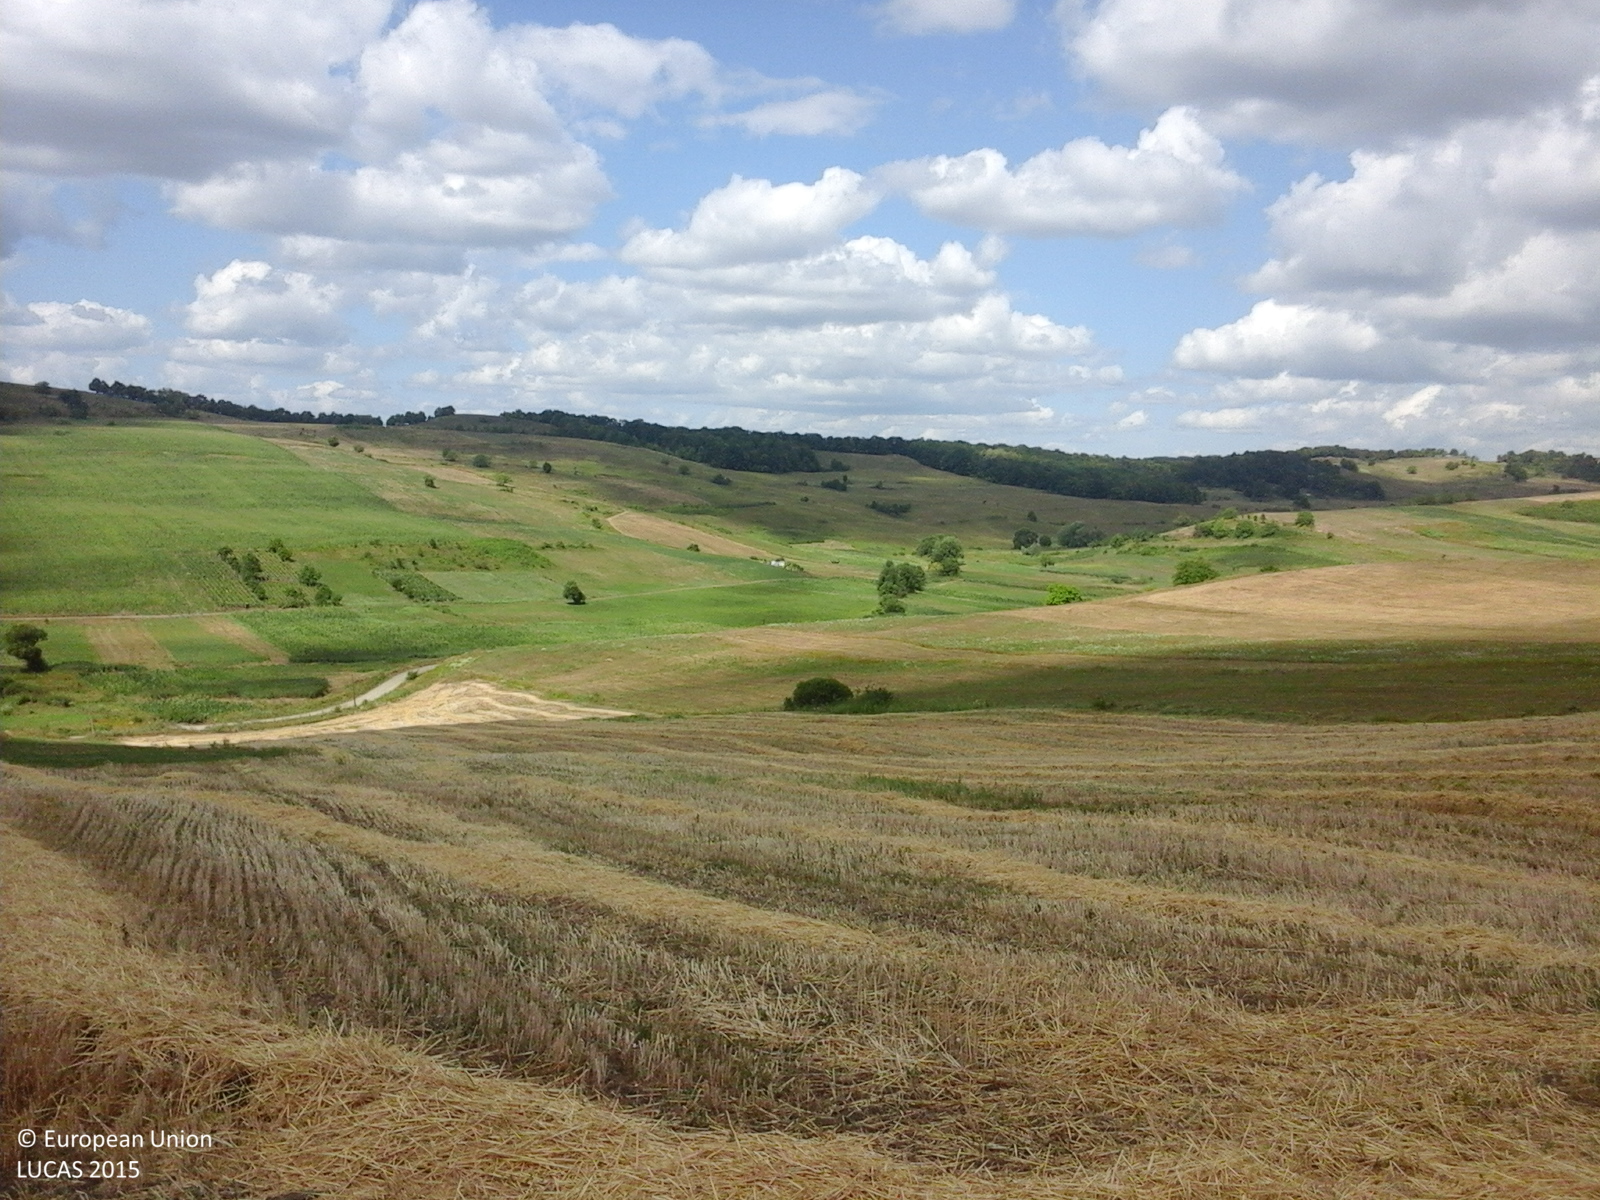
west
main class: Cropland
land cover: Triticale
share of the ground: 50 - 75 %
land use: Agriculture (excluding fallow land and kitchen gardens)
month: July
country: RO
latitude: 46.6152
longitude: 27.2221
